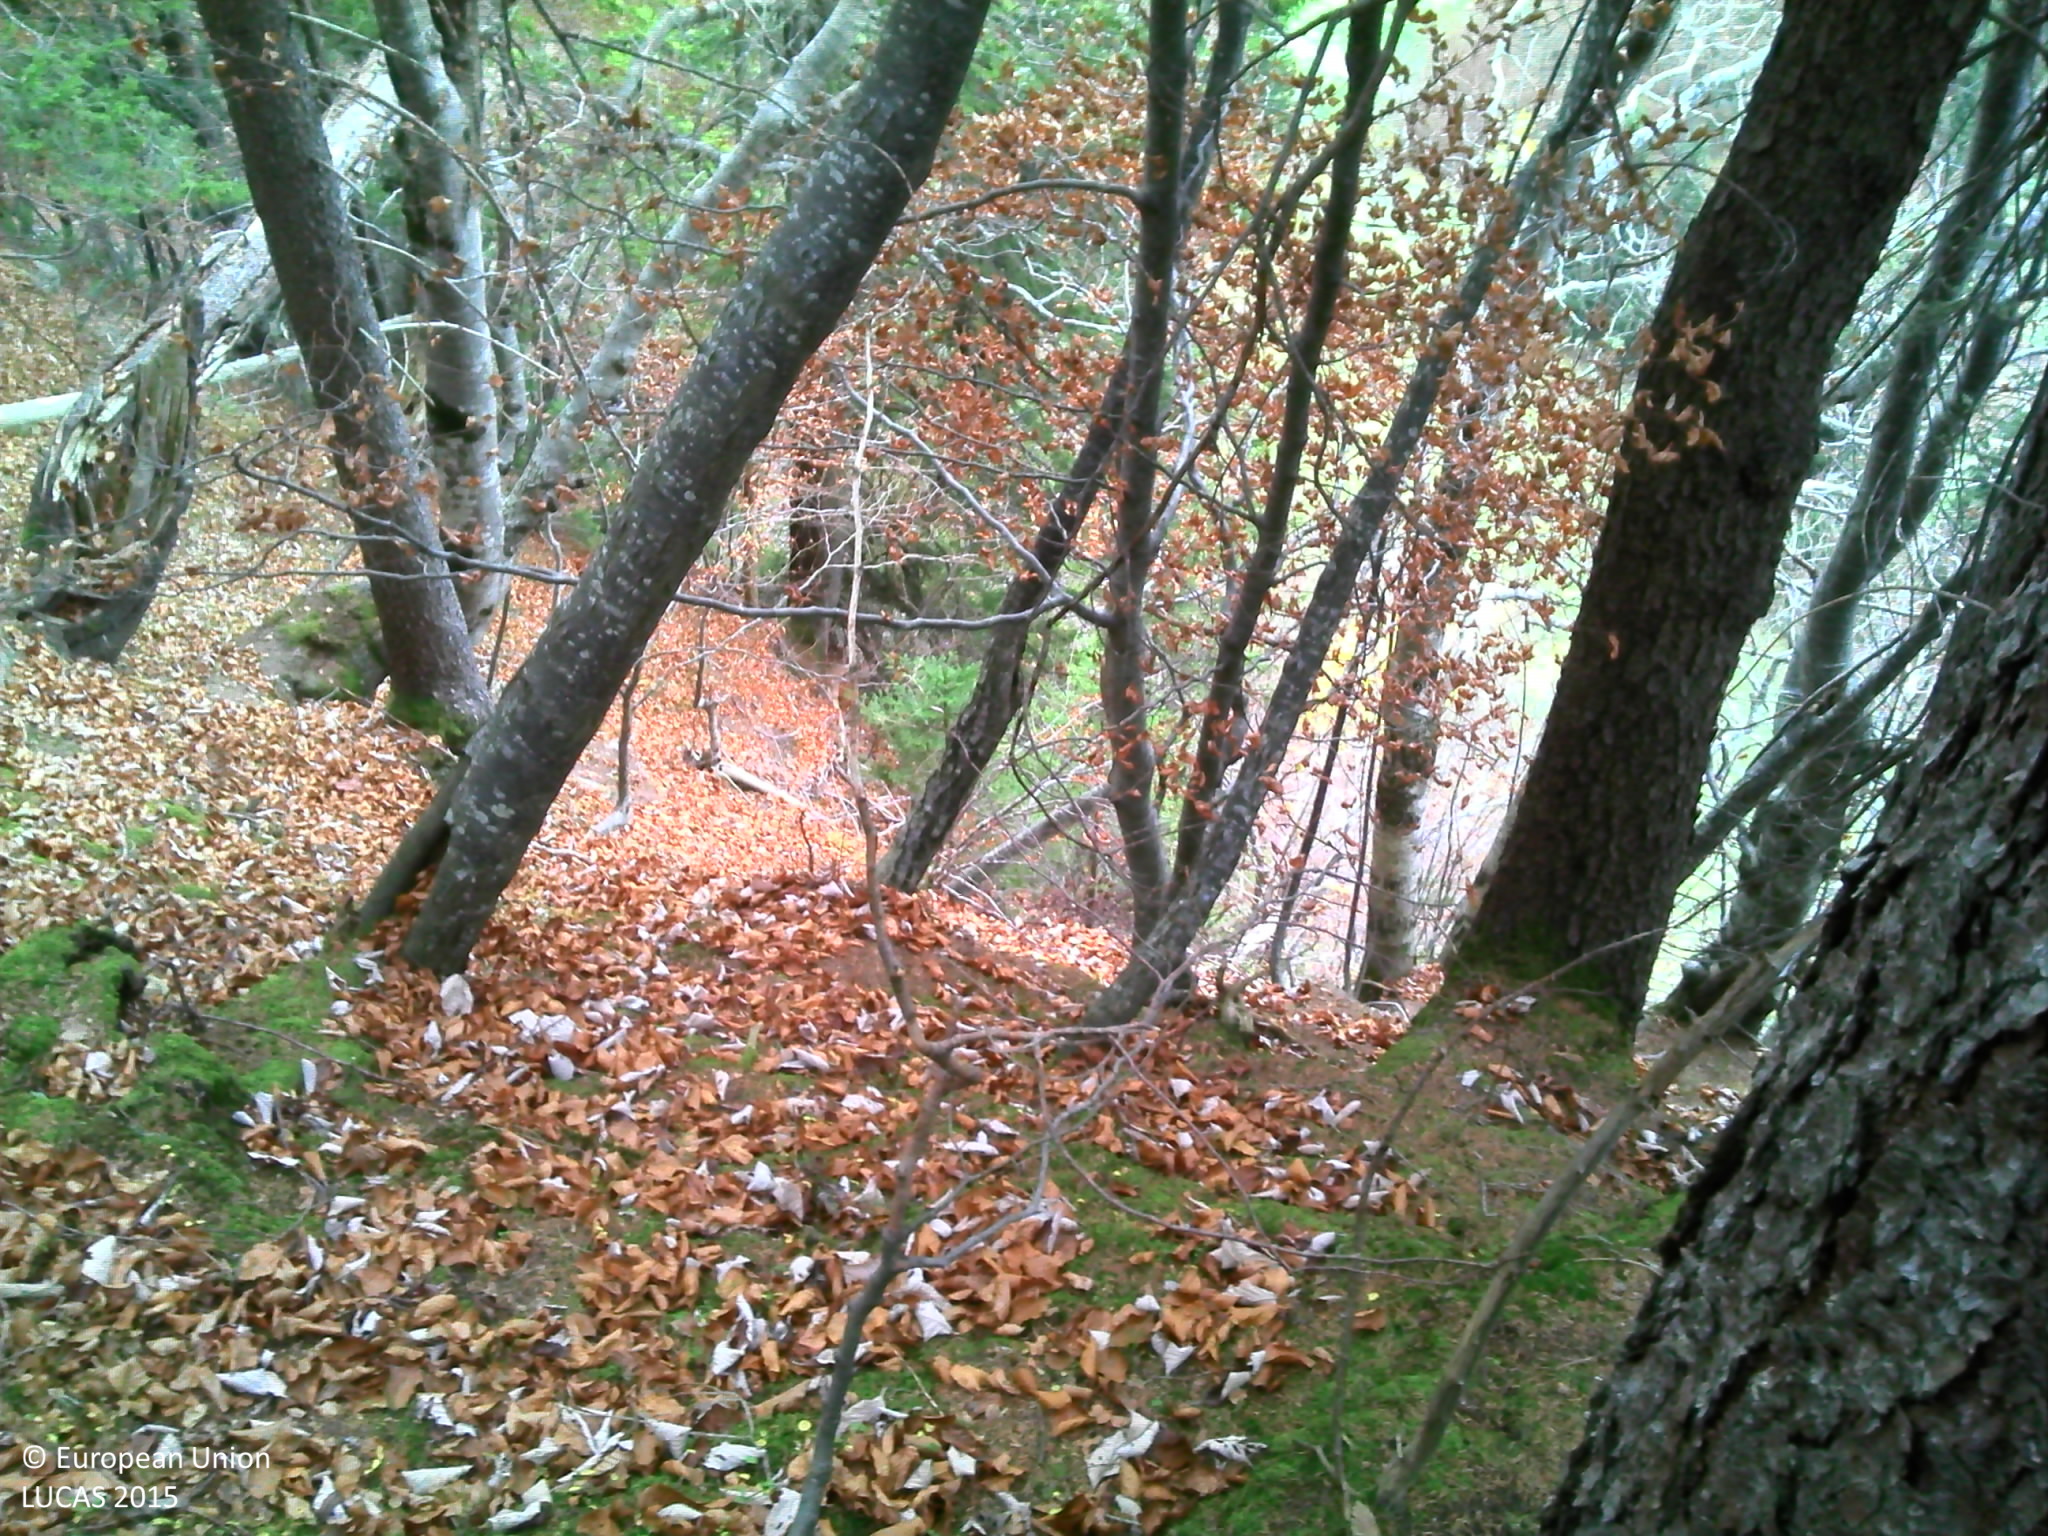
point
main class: Woodland
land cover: Spruce dominated mixed woodland
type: mountainous beech forest
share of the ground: > 75 %
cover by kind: coniferous forest trees 50 %, broadleaved forest trees 30 %, herbaceous plants 10 %, consolidated bare surface 10 %
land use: Forestry
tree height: > 5 m
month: November
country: FR
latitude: 45.8068
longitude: 6.4912
